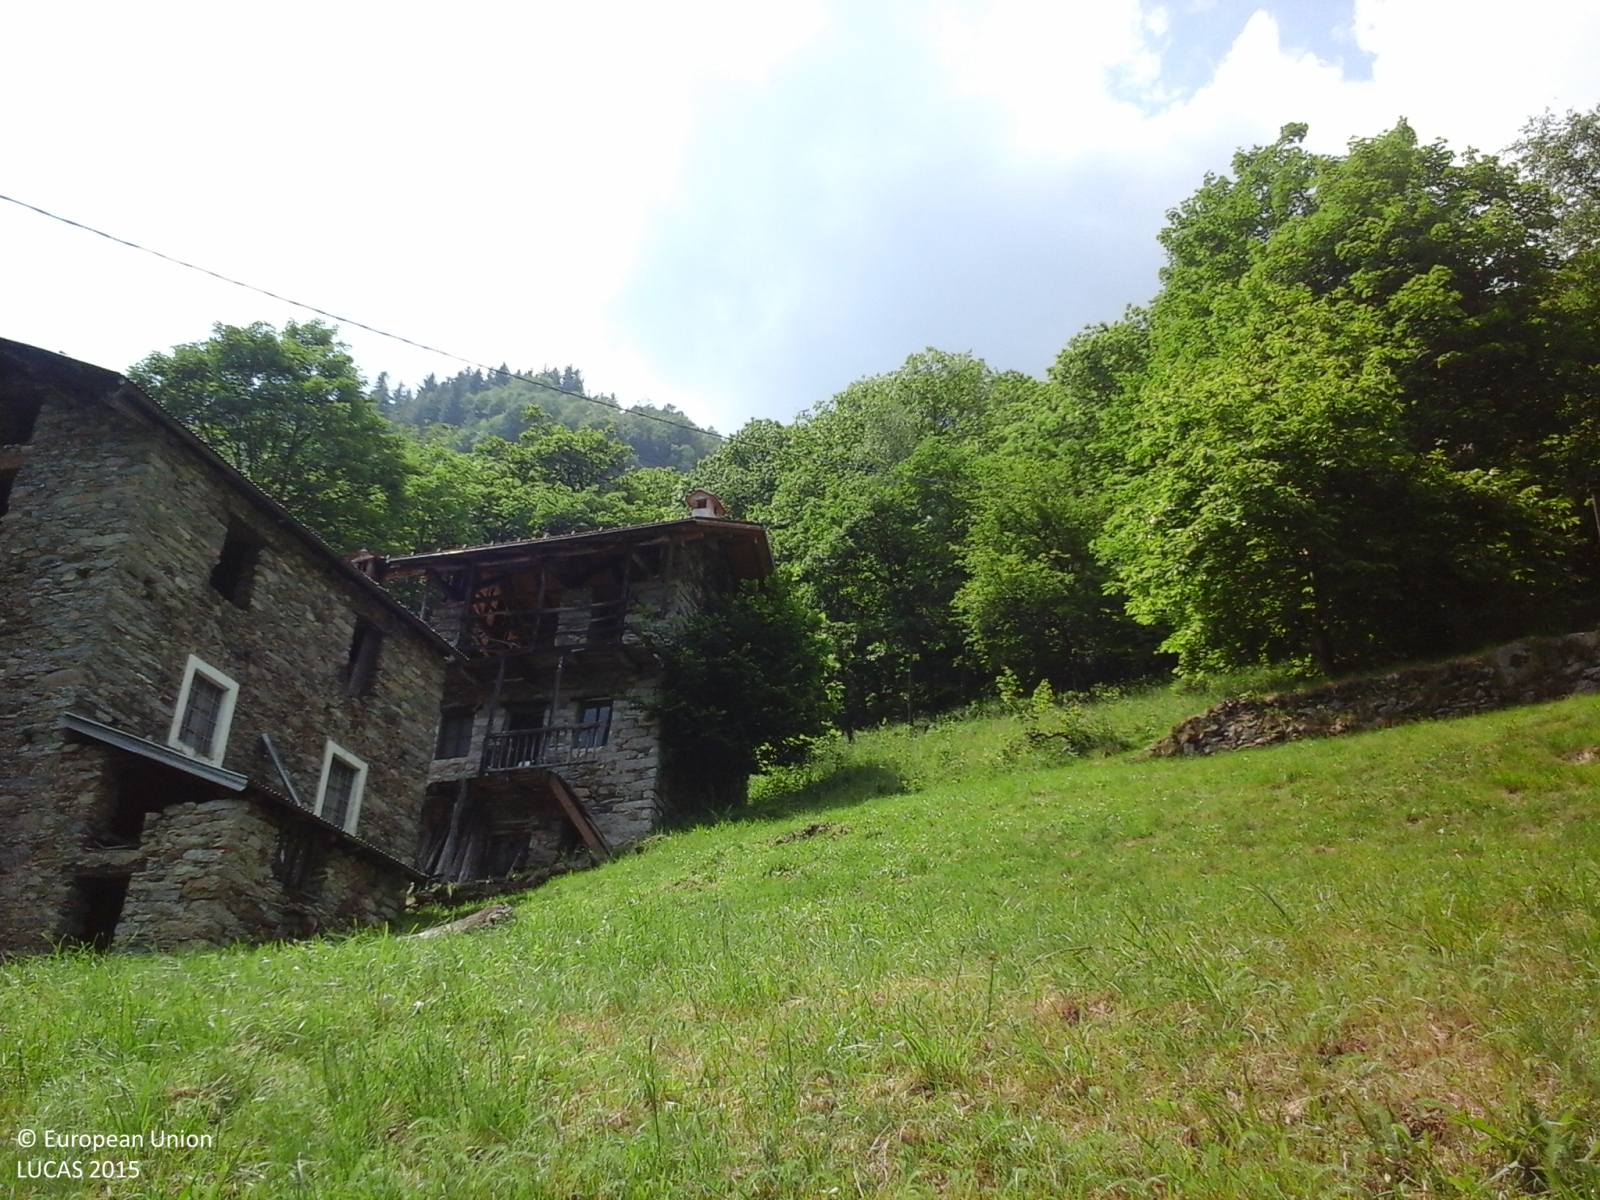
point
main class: Woodland
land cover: Broadleaved woodland
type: beech forest
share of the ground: > 75 %
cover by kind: broadleaved forest trees 100 %
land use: Forestry
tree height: > 5 m
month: June
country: IT
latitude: 45.8682
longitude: 8.2377
